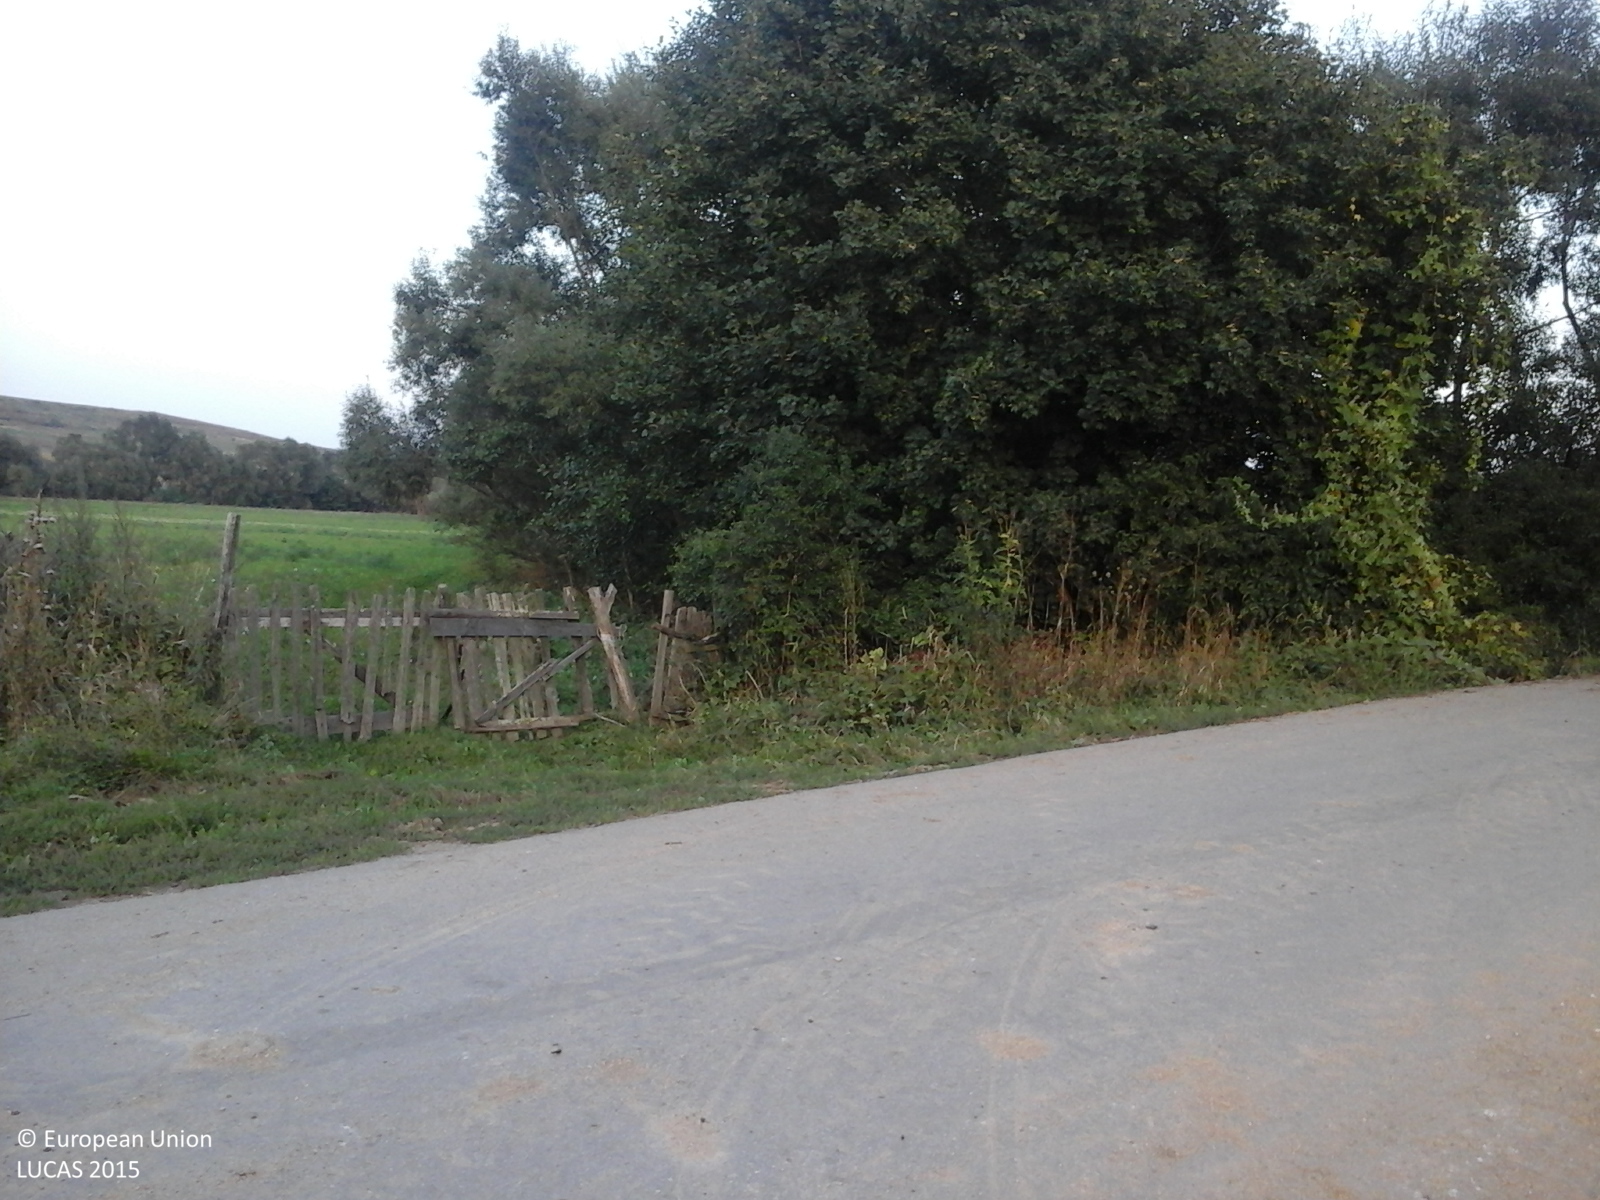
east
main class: Cropland
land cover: Maize
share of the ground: > 75 %
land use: Agriculture (excluding fallow land and kitchen gardens)
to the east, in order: Maize; Lucerne; Abandoned hedges; Ditches and canals; Abandoned hedges; Grassland without tree/shrub cover; Electric lines; Grassland without tree/shrub cover; Lines of trees; Grass margins; Ditches and canals; Grass margins; Paved roads, cycling and walking lanes; Grass margins; Ditches and canals; Abandoned hedges; Grassland without tree/shrub cover; Electric lines; Grassland without tree/shrub cover; Abandoned hedges
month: September
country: RO
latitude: 47.1629
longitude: 22.6552
